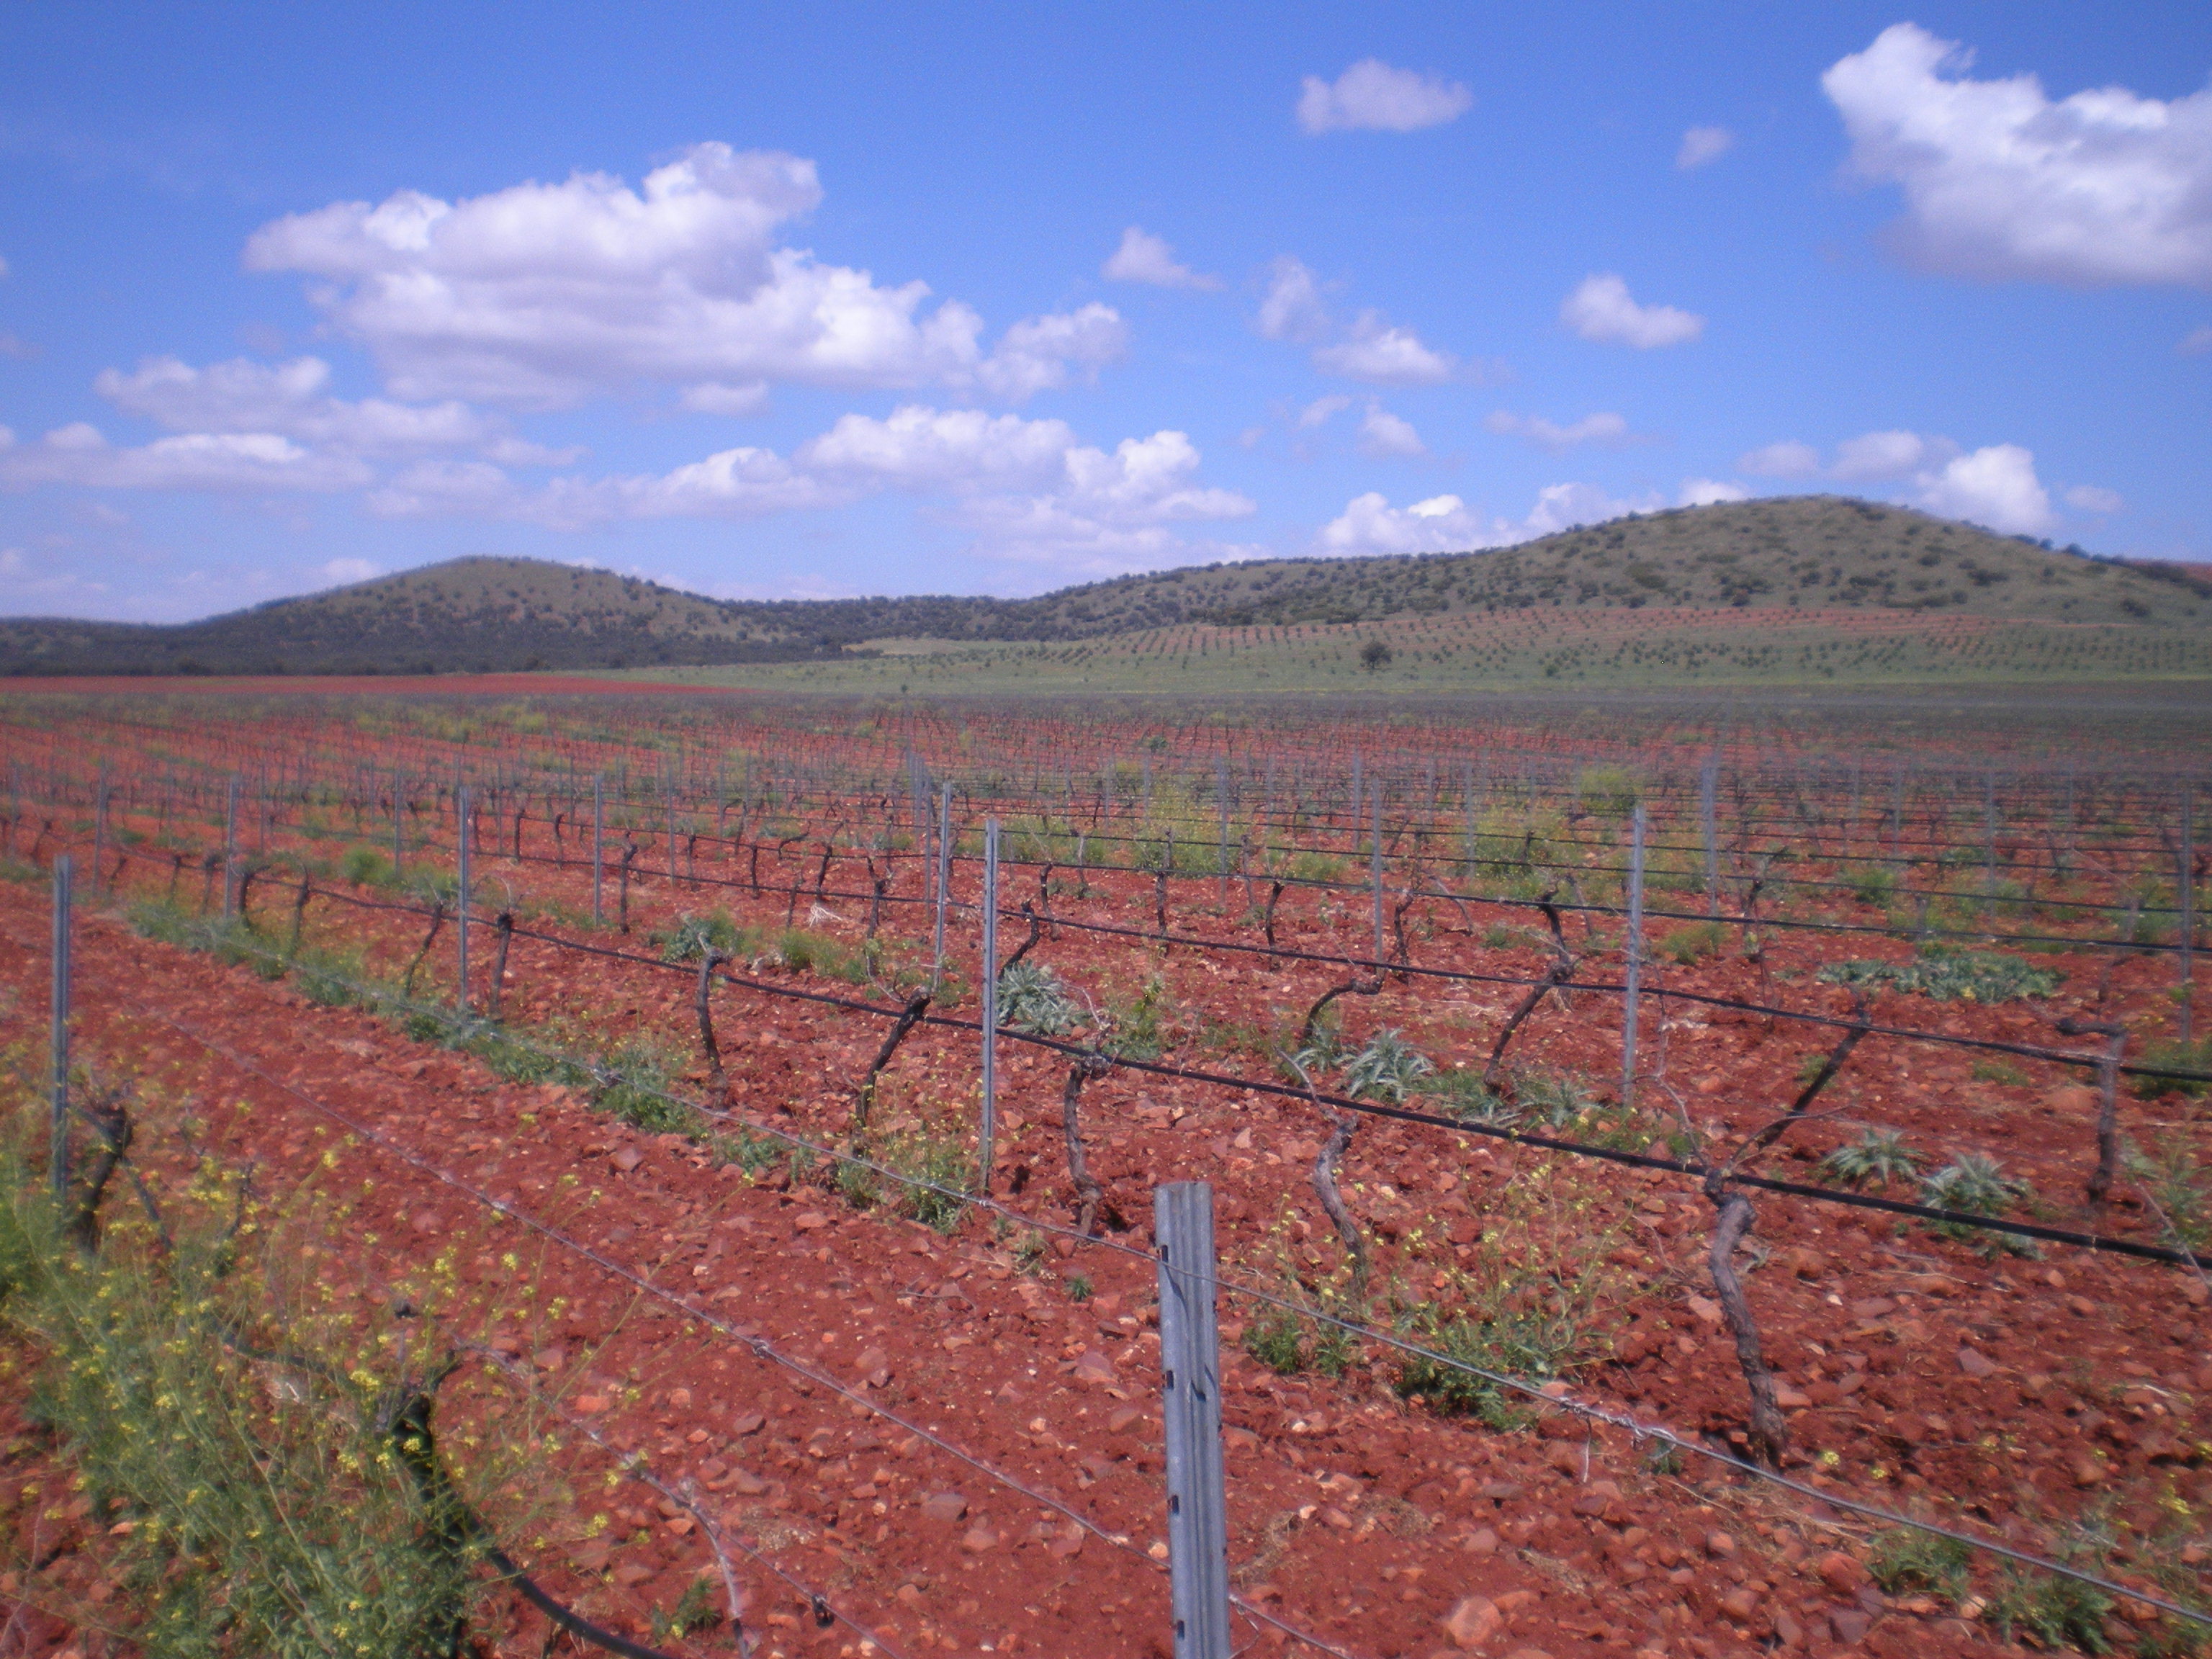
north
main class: Cropland
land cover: Vineyards
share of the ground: < 10 %
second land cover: Spontaneously vegetated surfaces
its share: < 10 %
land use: Agriculture (excluding fallow land and kitchen gardens)
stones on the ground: 10 - 25 %
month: April
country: ES
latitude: 38.7179
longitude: -3.5490
